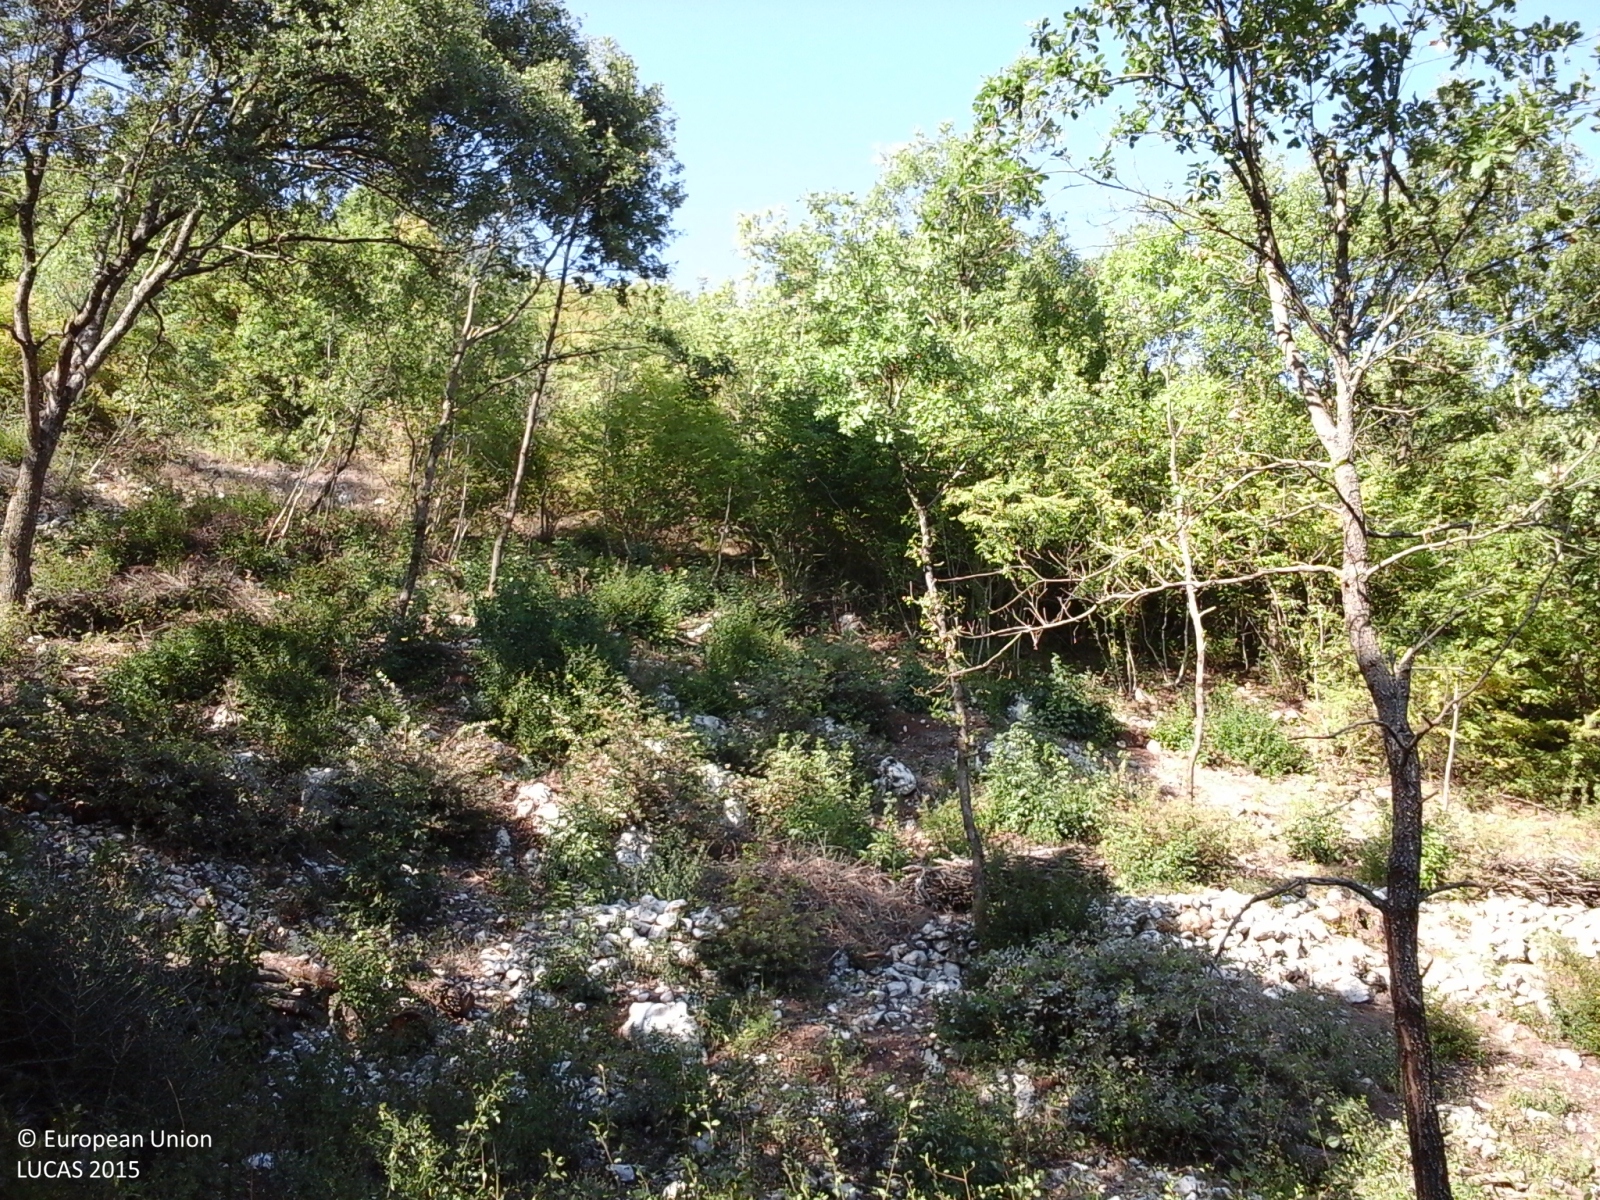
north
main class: Woodland
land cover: Broadleaved woodland
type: thermophilous deciduous forest
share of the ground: > 75 %
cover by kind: broadleaved forest trees 80 %, shrubs 15 %, herbaceous plants 5 %
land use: Semi-natural and natural areas not in use
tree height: > 5 m
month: September
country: IT
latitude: 41.6083
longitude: 14.1968
